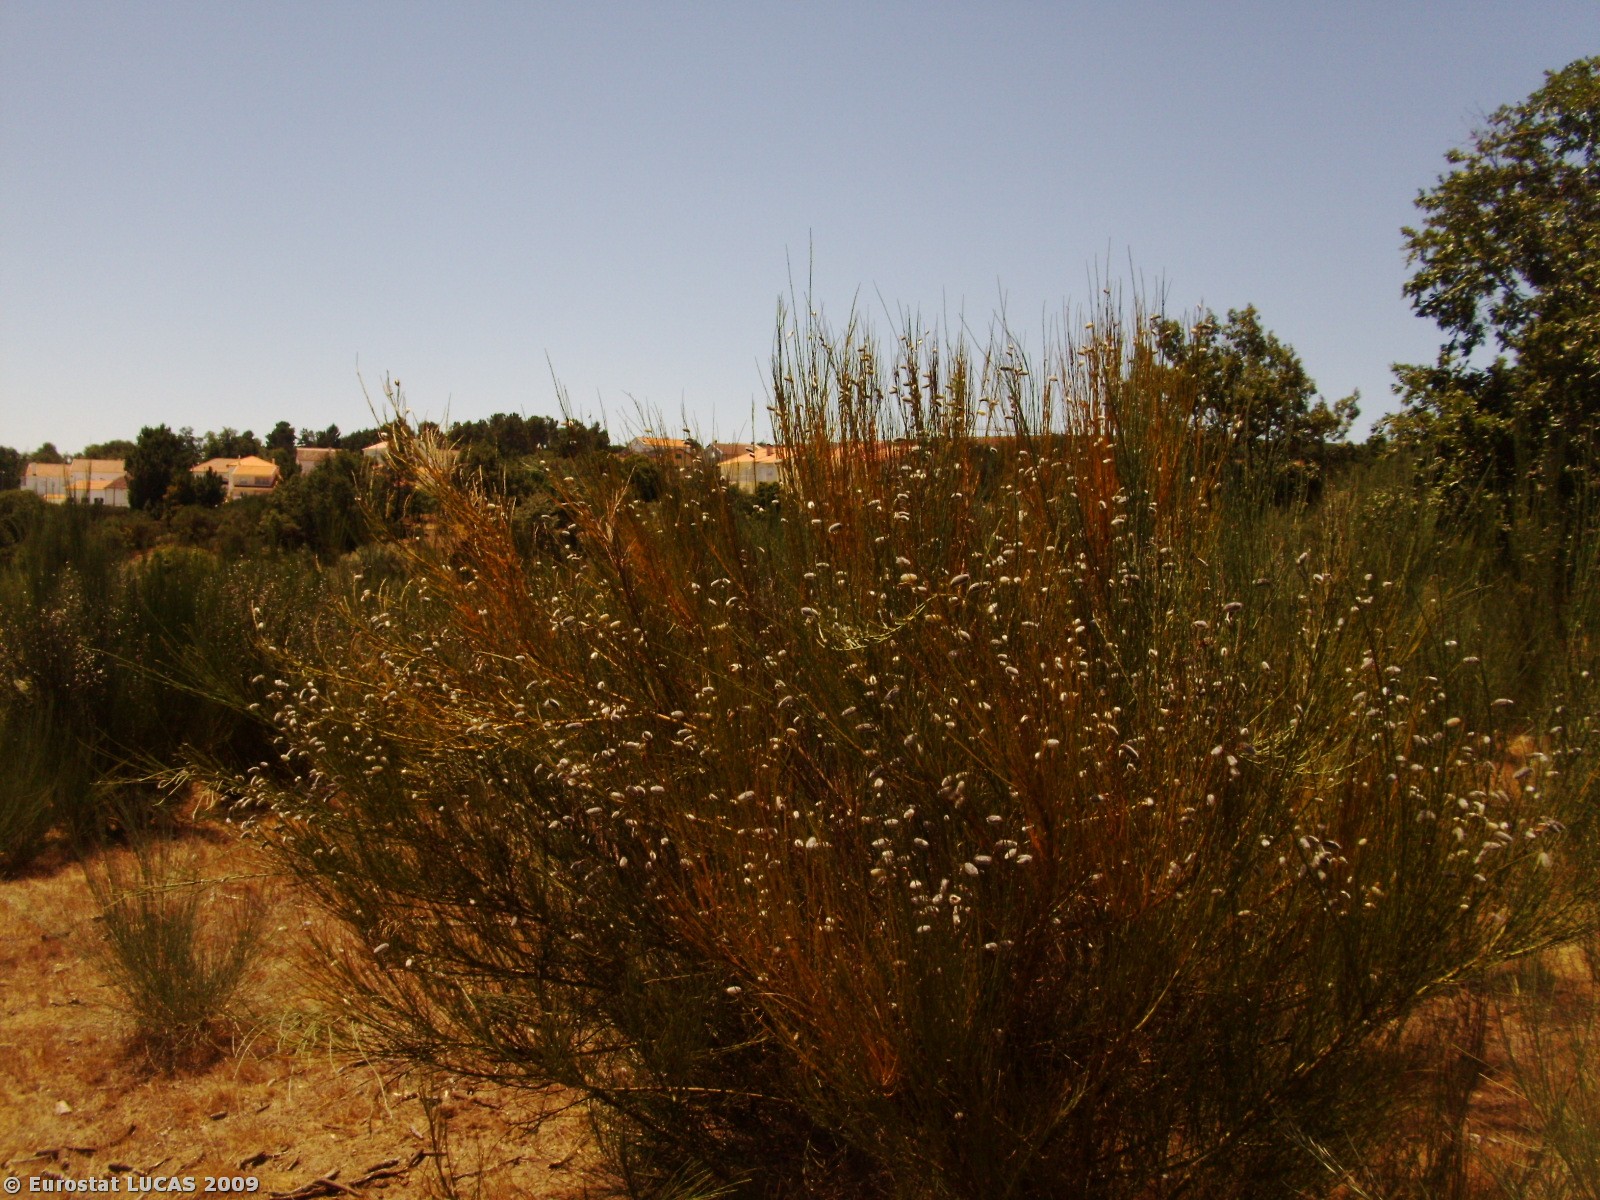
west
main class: Shrubland
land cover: Shrubland with sparse tree cover
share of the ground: > 75 %
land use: Forestry
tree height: > 5 m
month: July
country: PT
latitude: 40.5366
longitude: -7.2358
